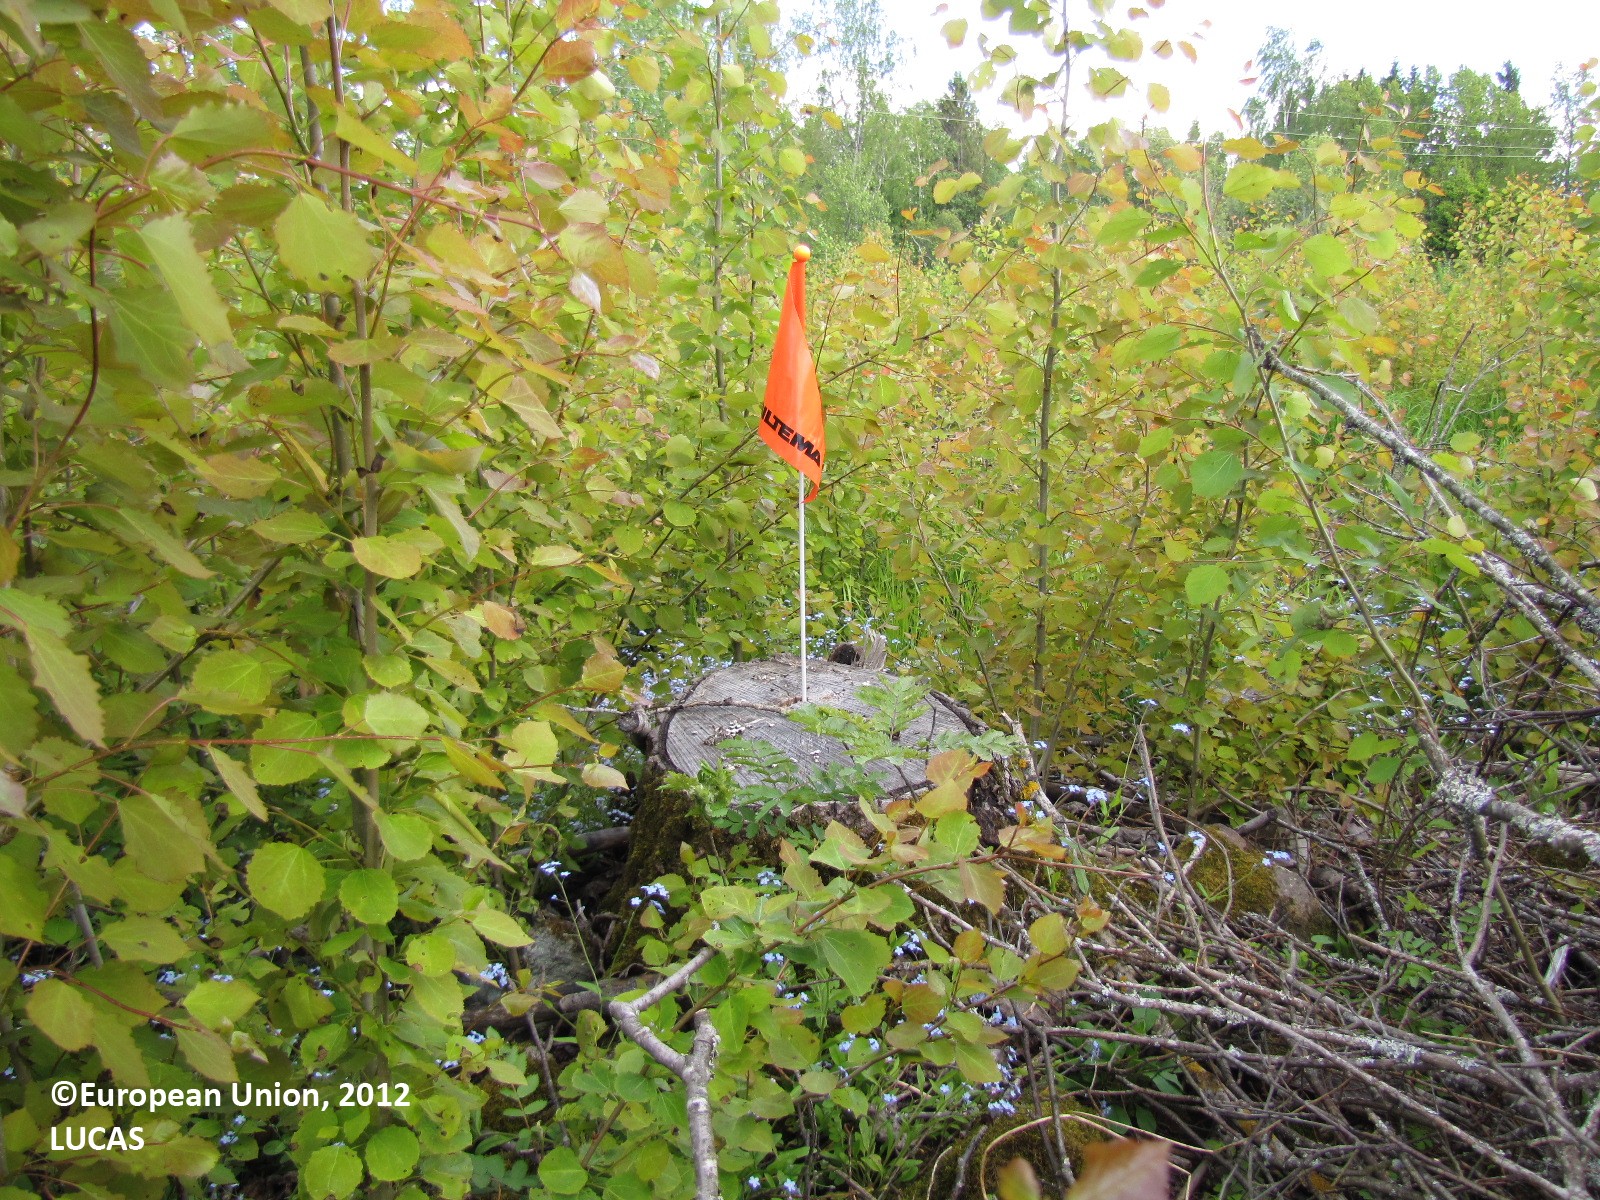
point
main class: Woodland
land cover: Broadleaved woodland
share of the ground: 25 - 50 %
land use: Semi-natural and natural areas not in use
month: June
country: FI
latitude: 61.4213
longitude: 23.0209
